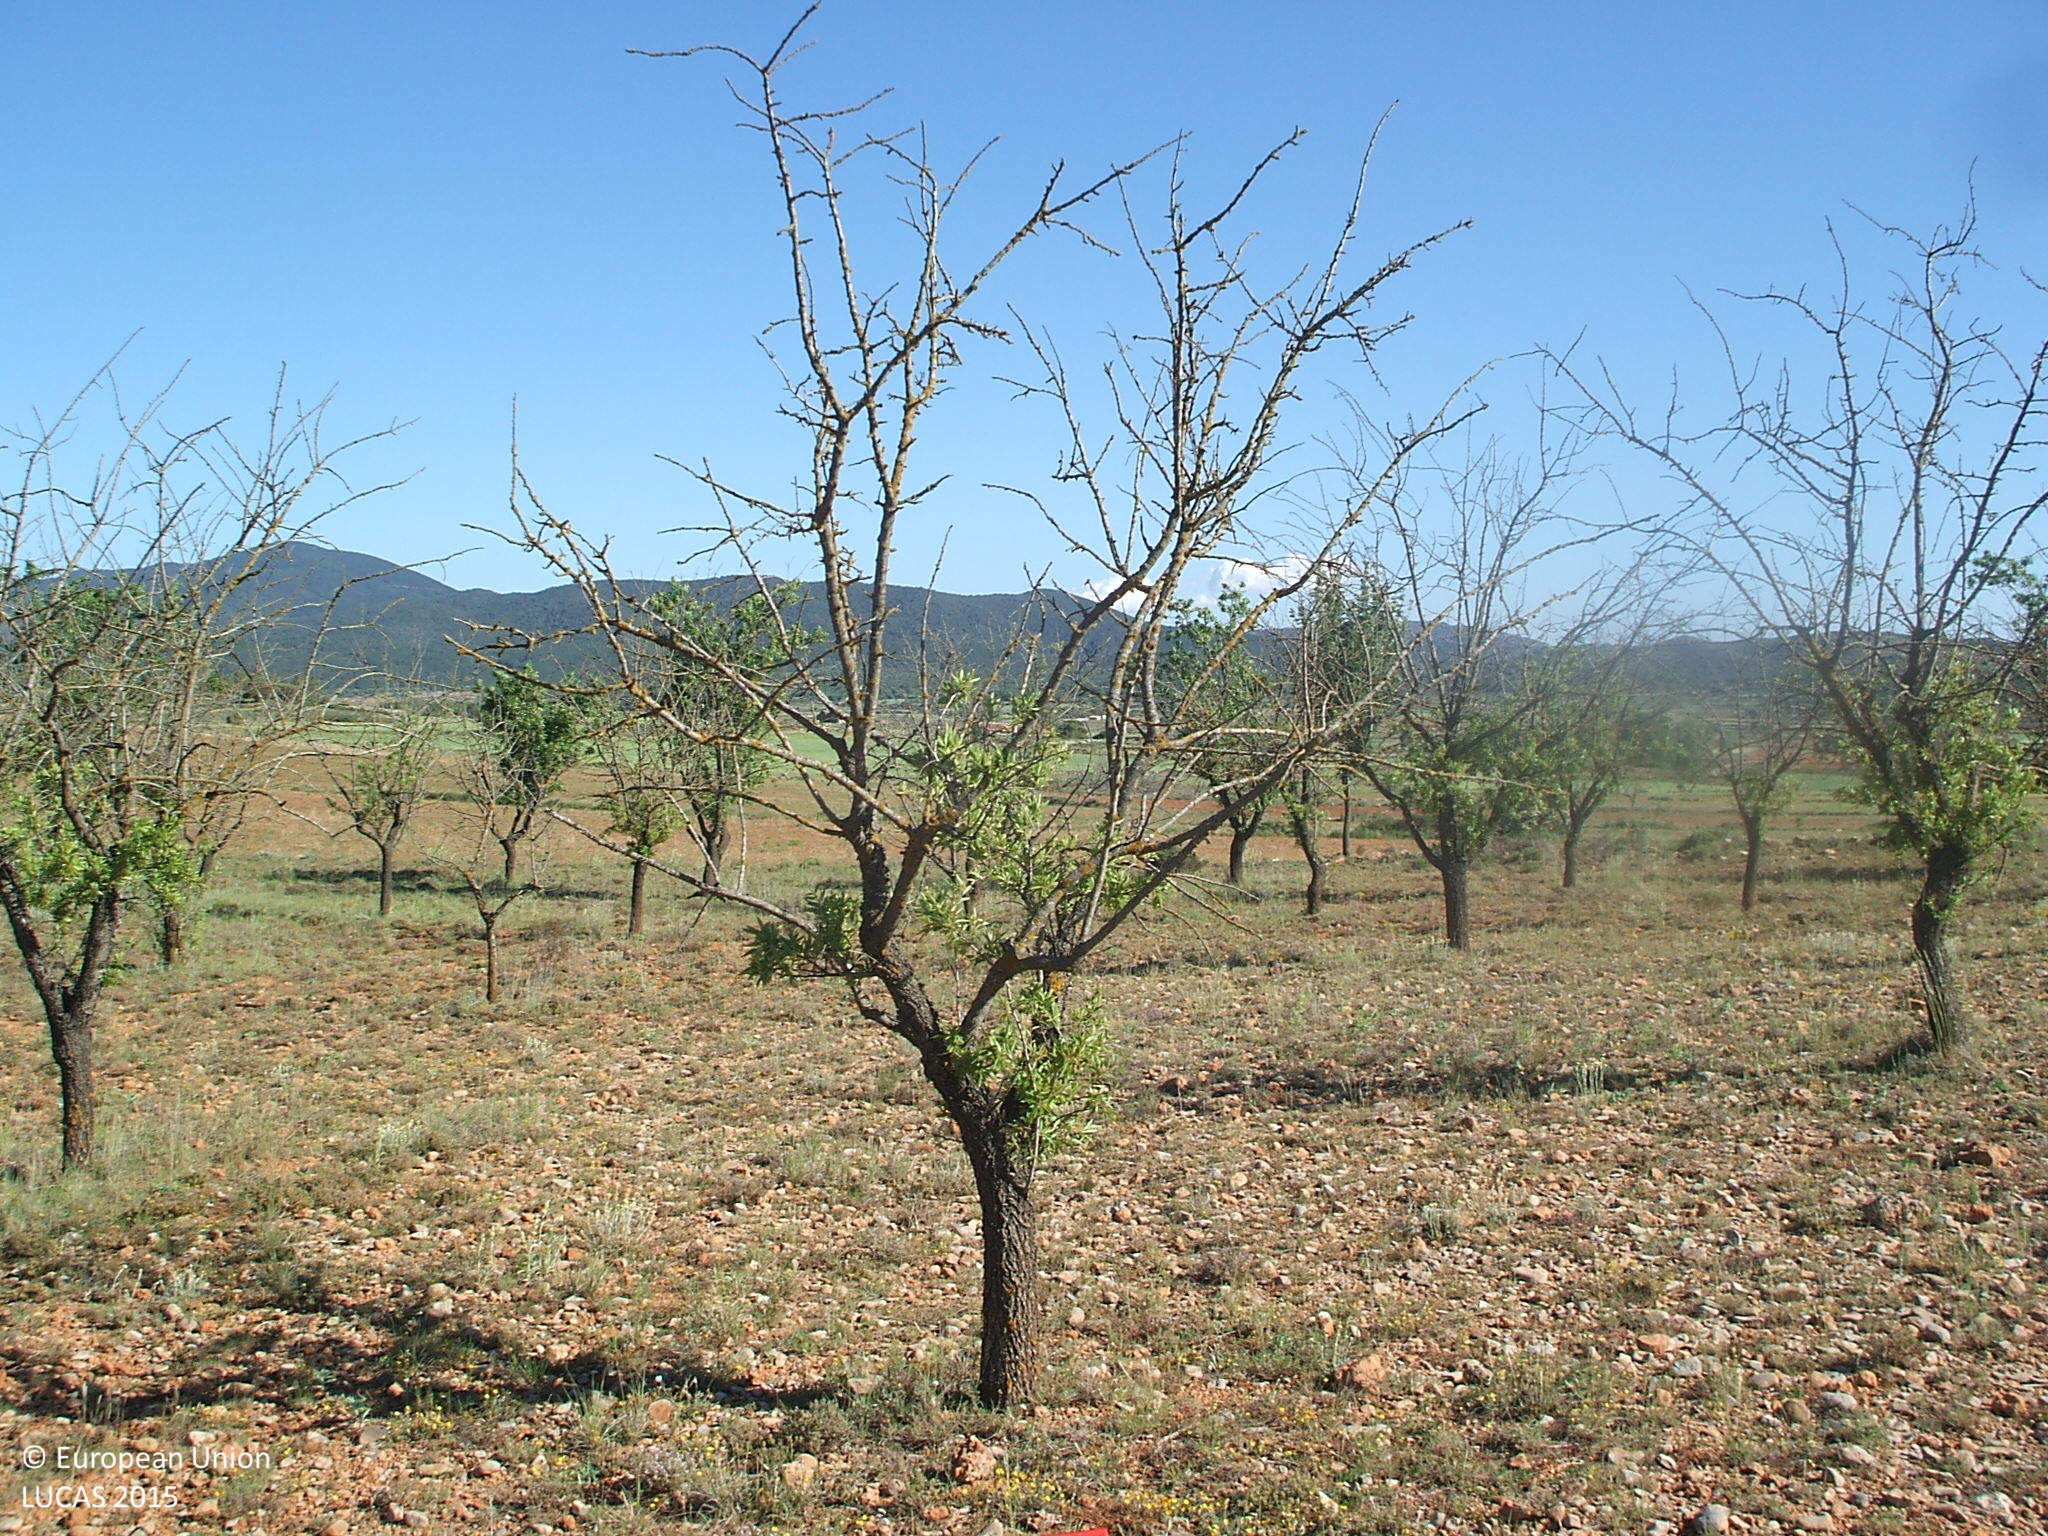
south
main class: Cropland
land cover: Nuts trees
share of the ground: 10 - 25 %
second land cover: Spontaneously vegetated surfaces
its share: 25 - 50 %
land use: Agriculture (excluding fallow land and kitchen gardens)
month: May
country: ES
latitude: 40.0829
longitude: -0.6890
